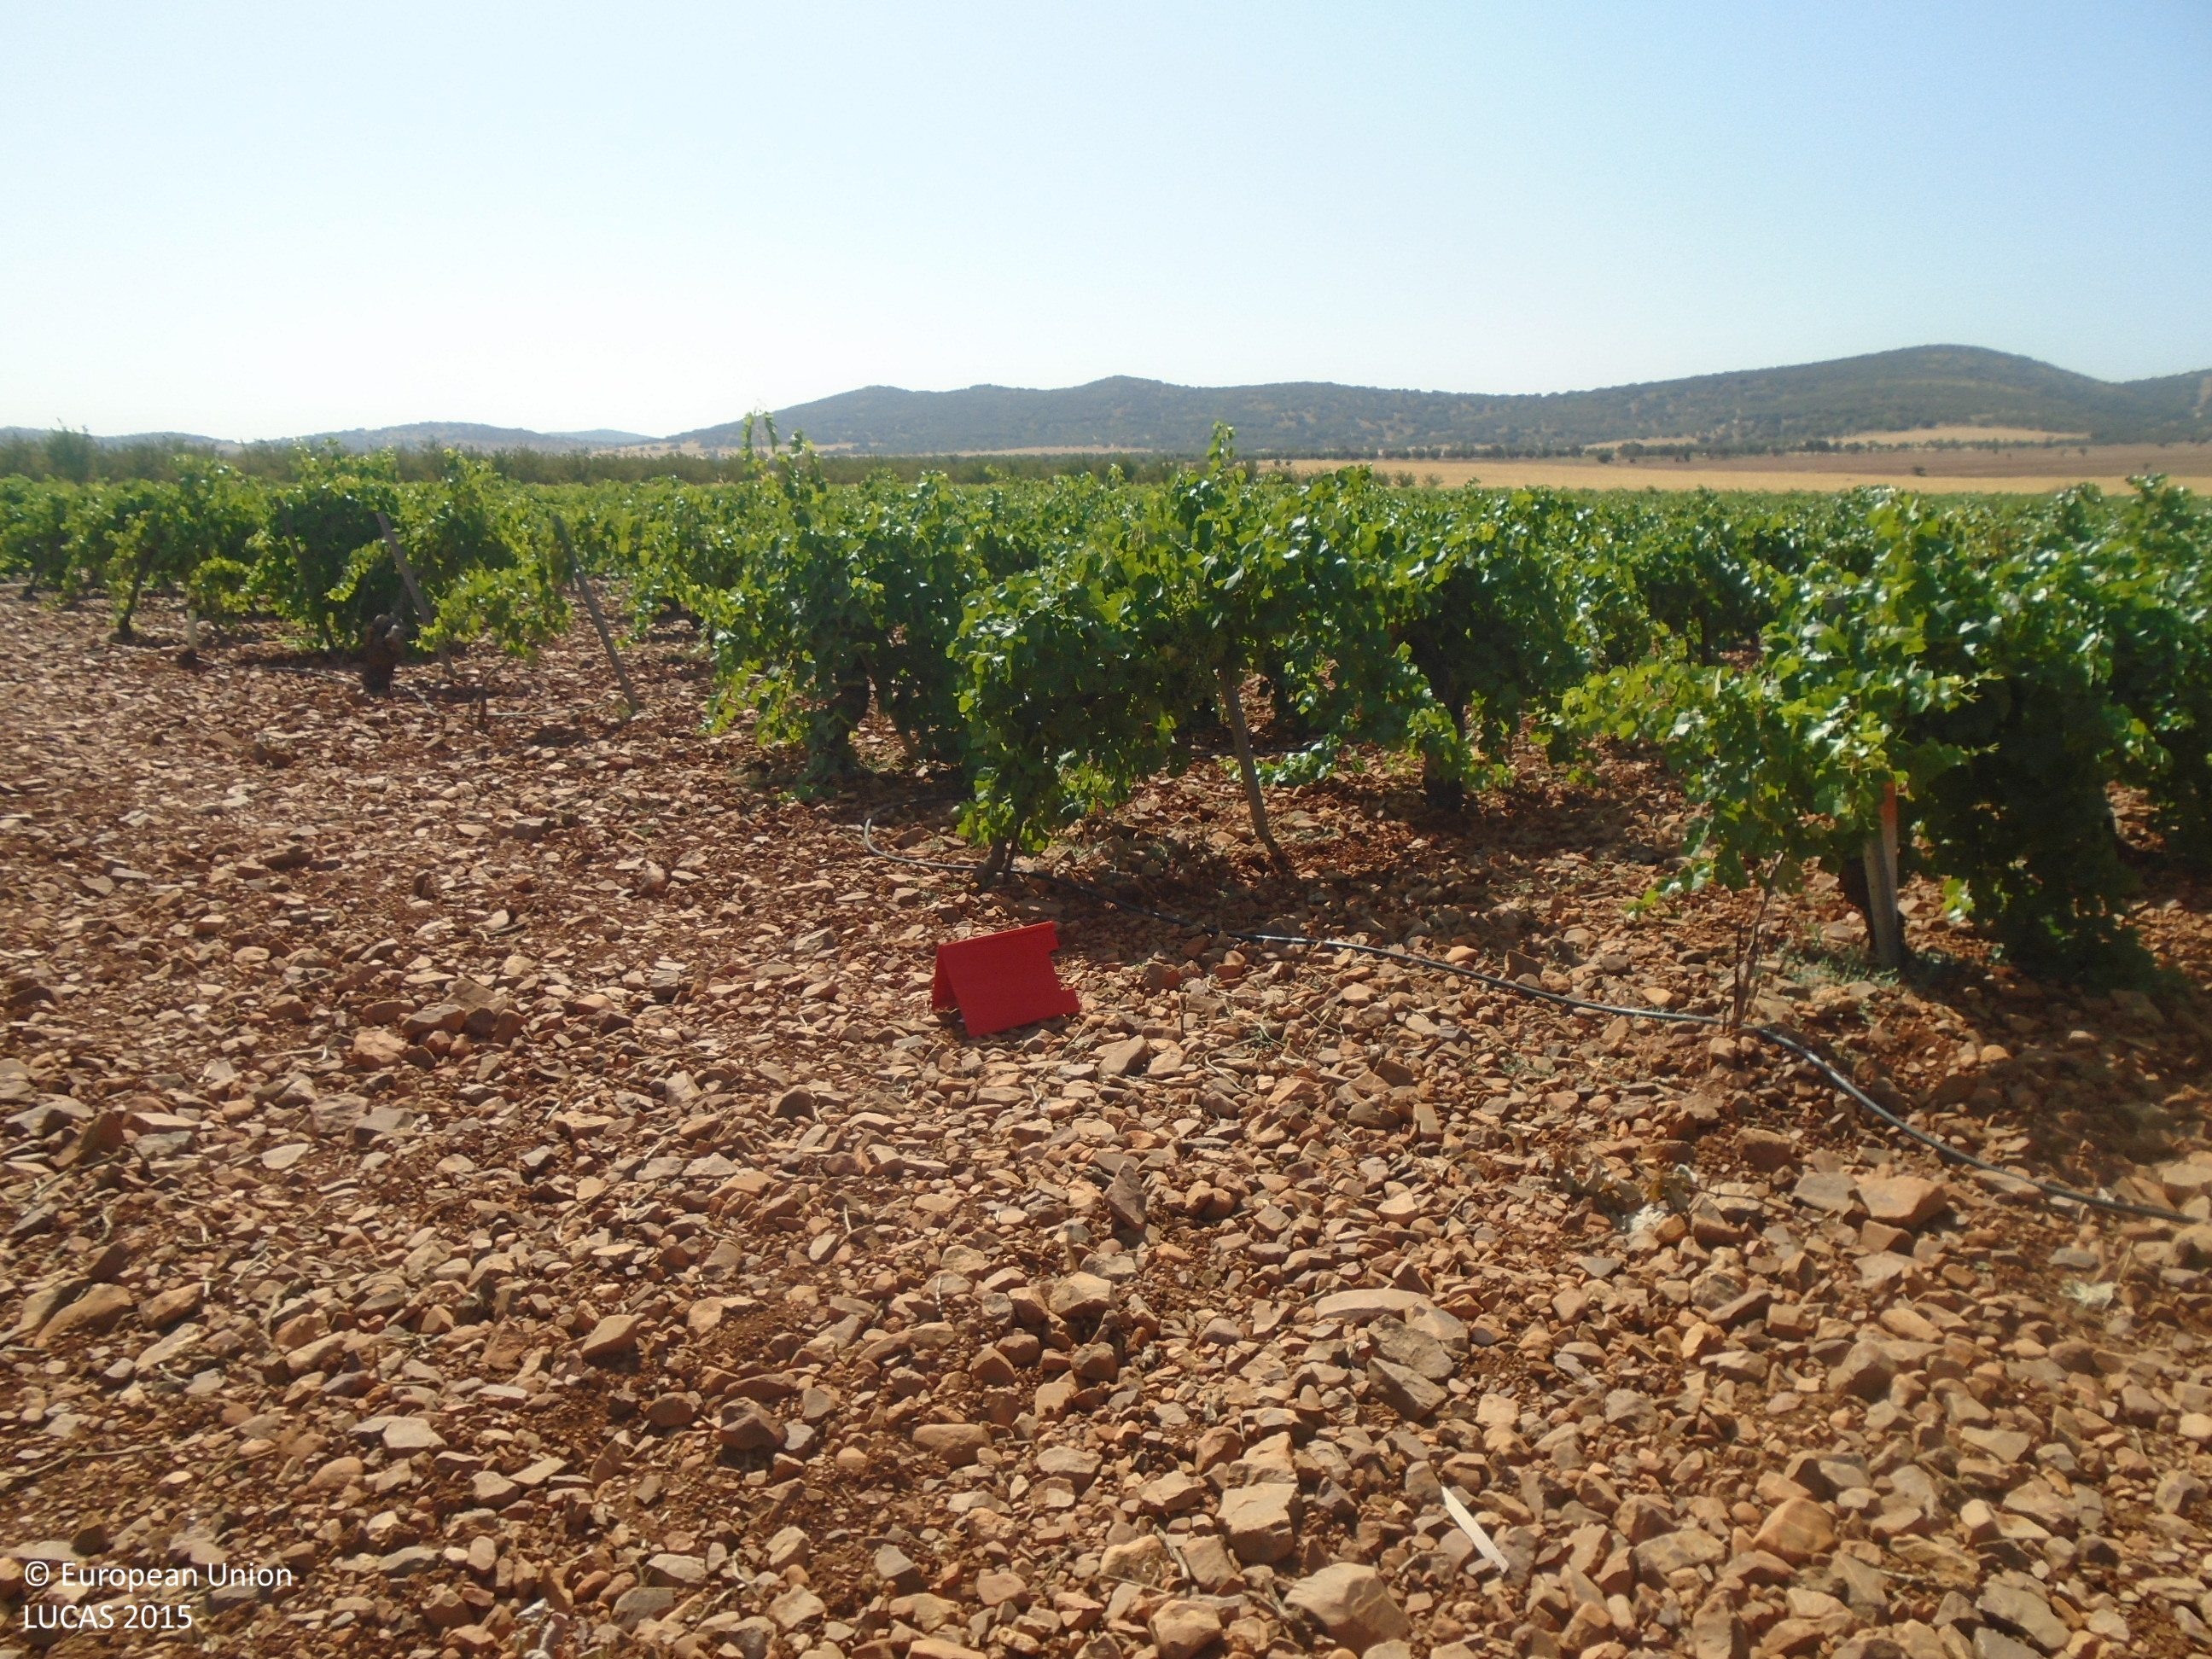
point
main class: Cropland
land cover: Vineyards
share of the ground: 25 - 50 %
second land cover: Other bare soil
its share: > 75 %
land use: Agriculture (excluding fallow land and kitchen gardens)
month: July
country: ES
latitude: 39.3975
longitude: -3.6673
